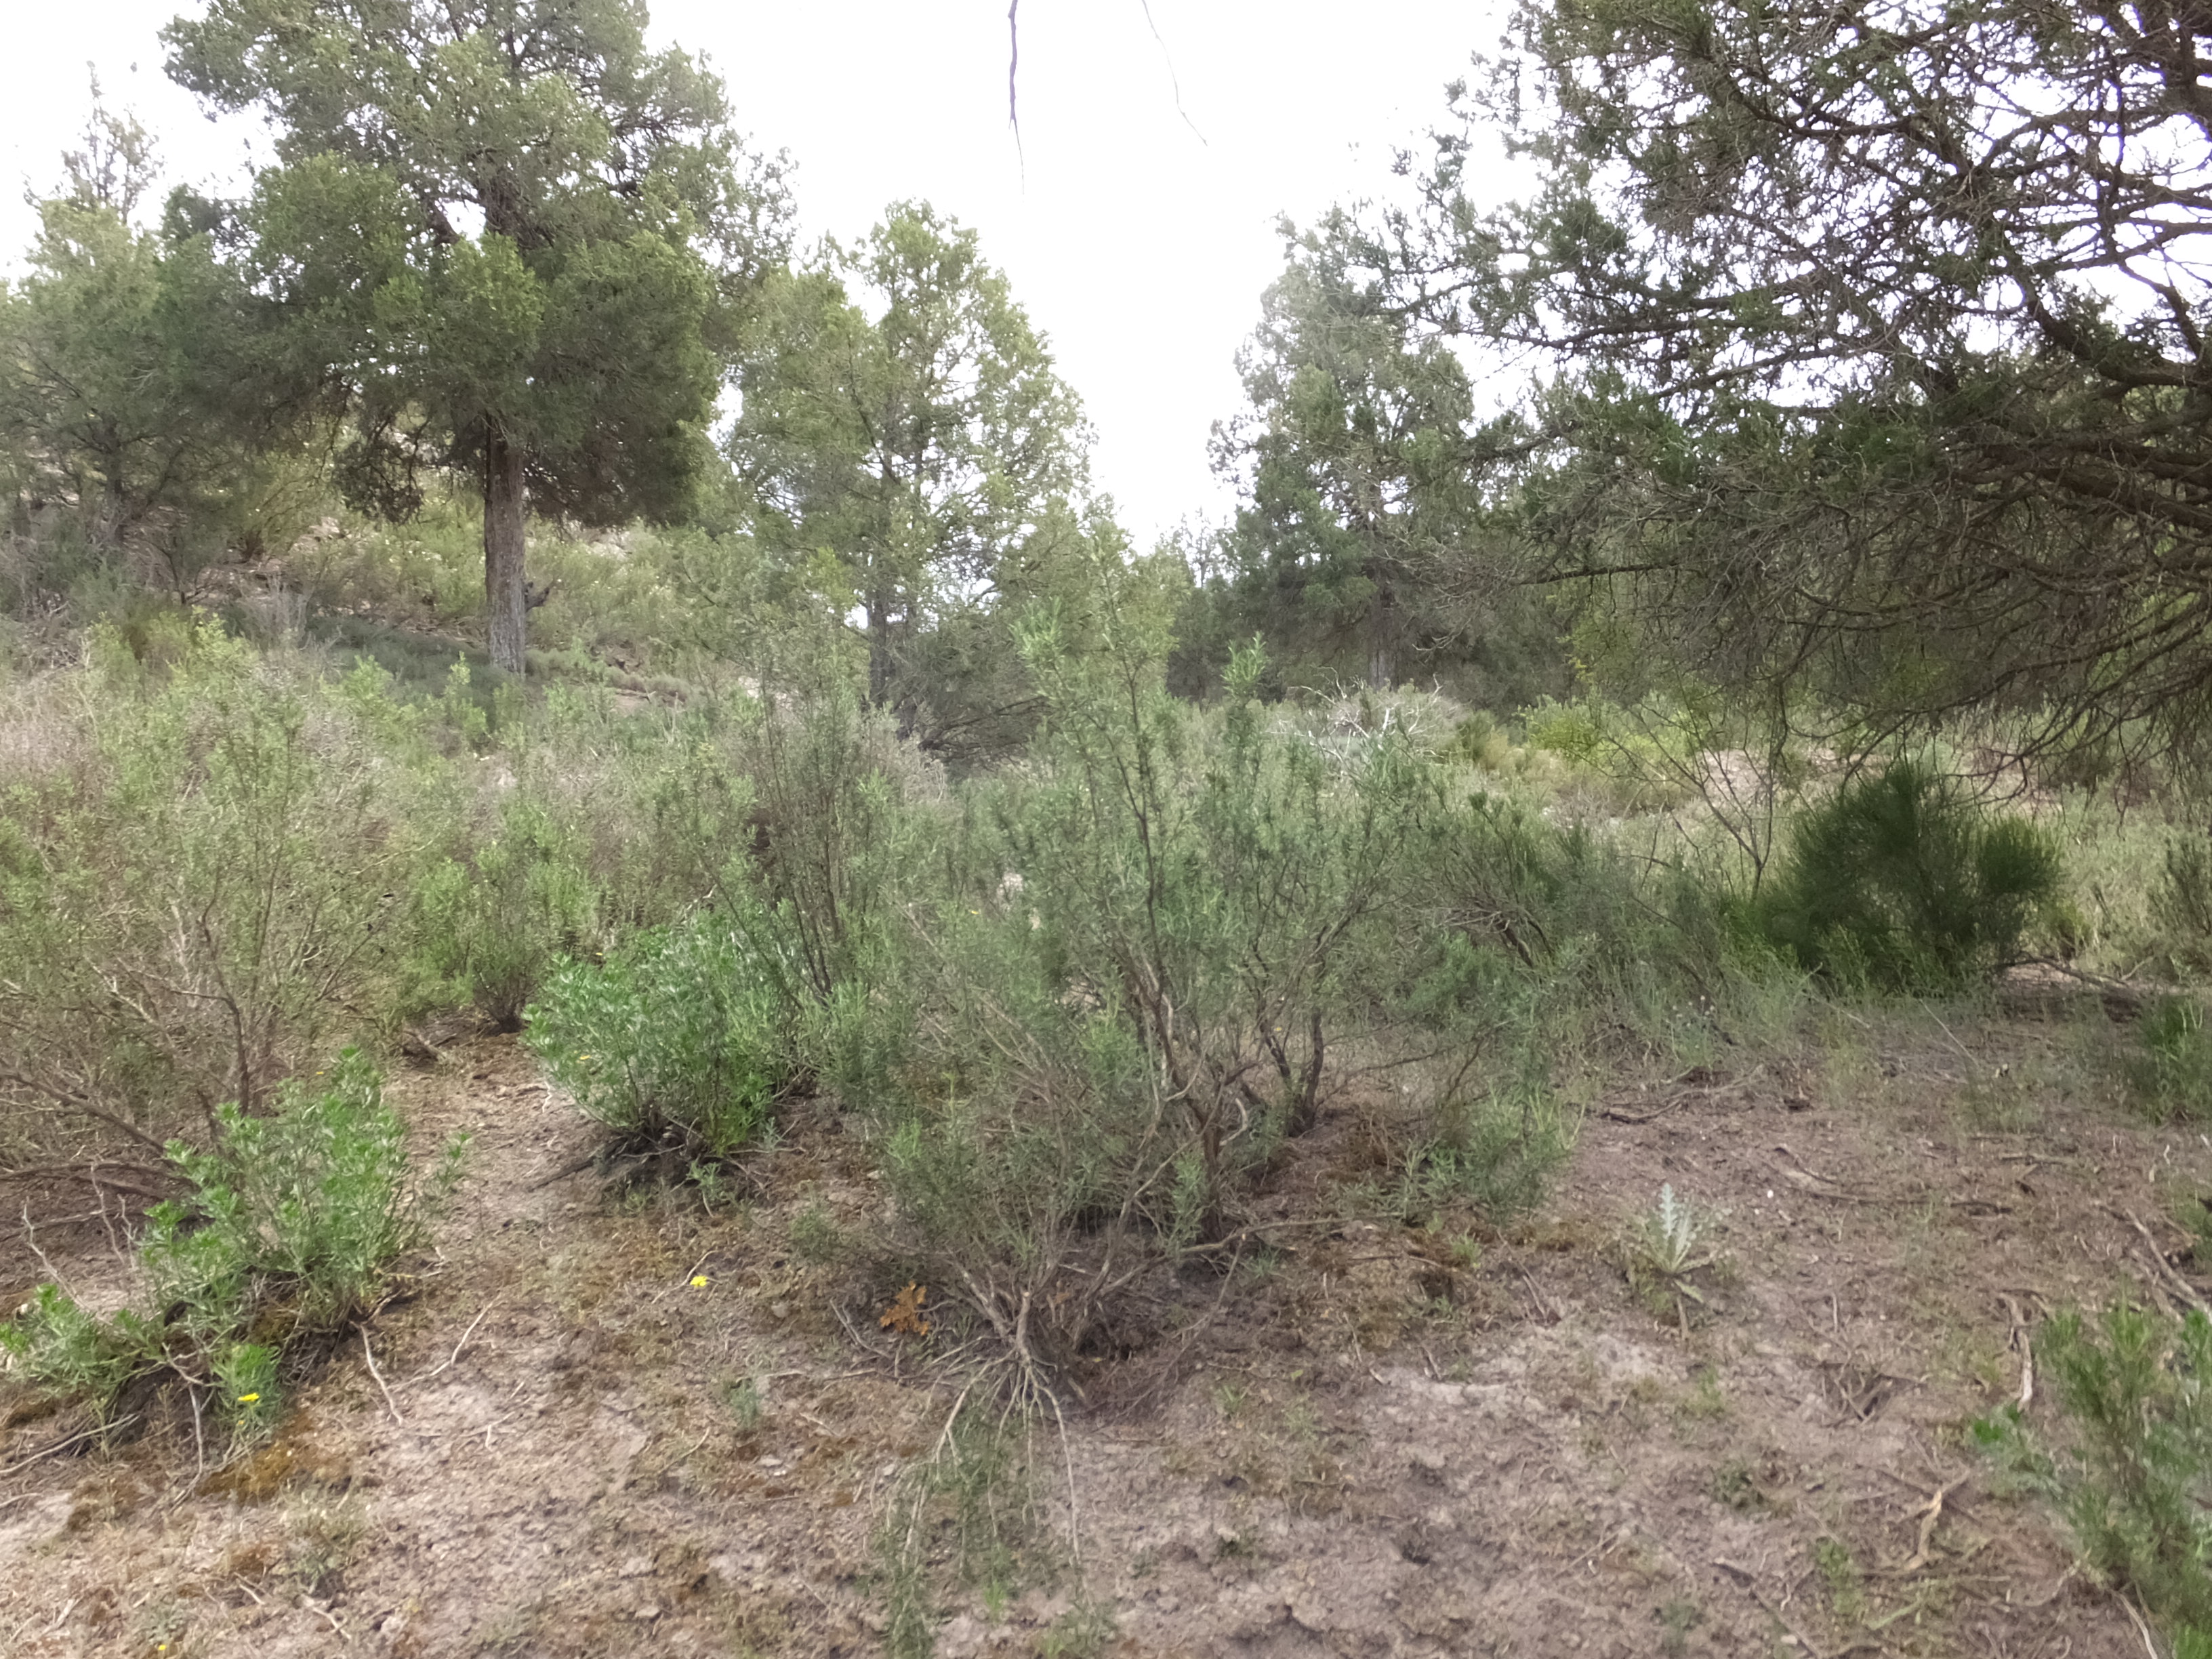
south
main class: Woodland
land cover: Pine dominated mixed woodland
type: coniferous forest of the mediterranean region
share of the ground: 50 - 75 %
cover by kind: coniferous forest trees 60 %, broadleaved forest trees 20 %, shrubs 20 %
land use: Forestry
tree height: > 5 m
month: May
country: ES
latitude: 41.4747
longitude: -0.2784
